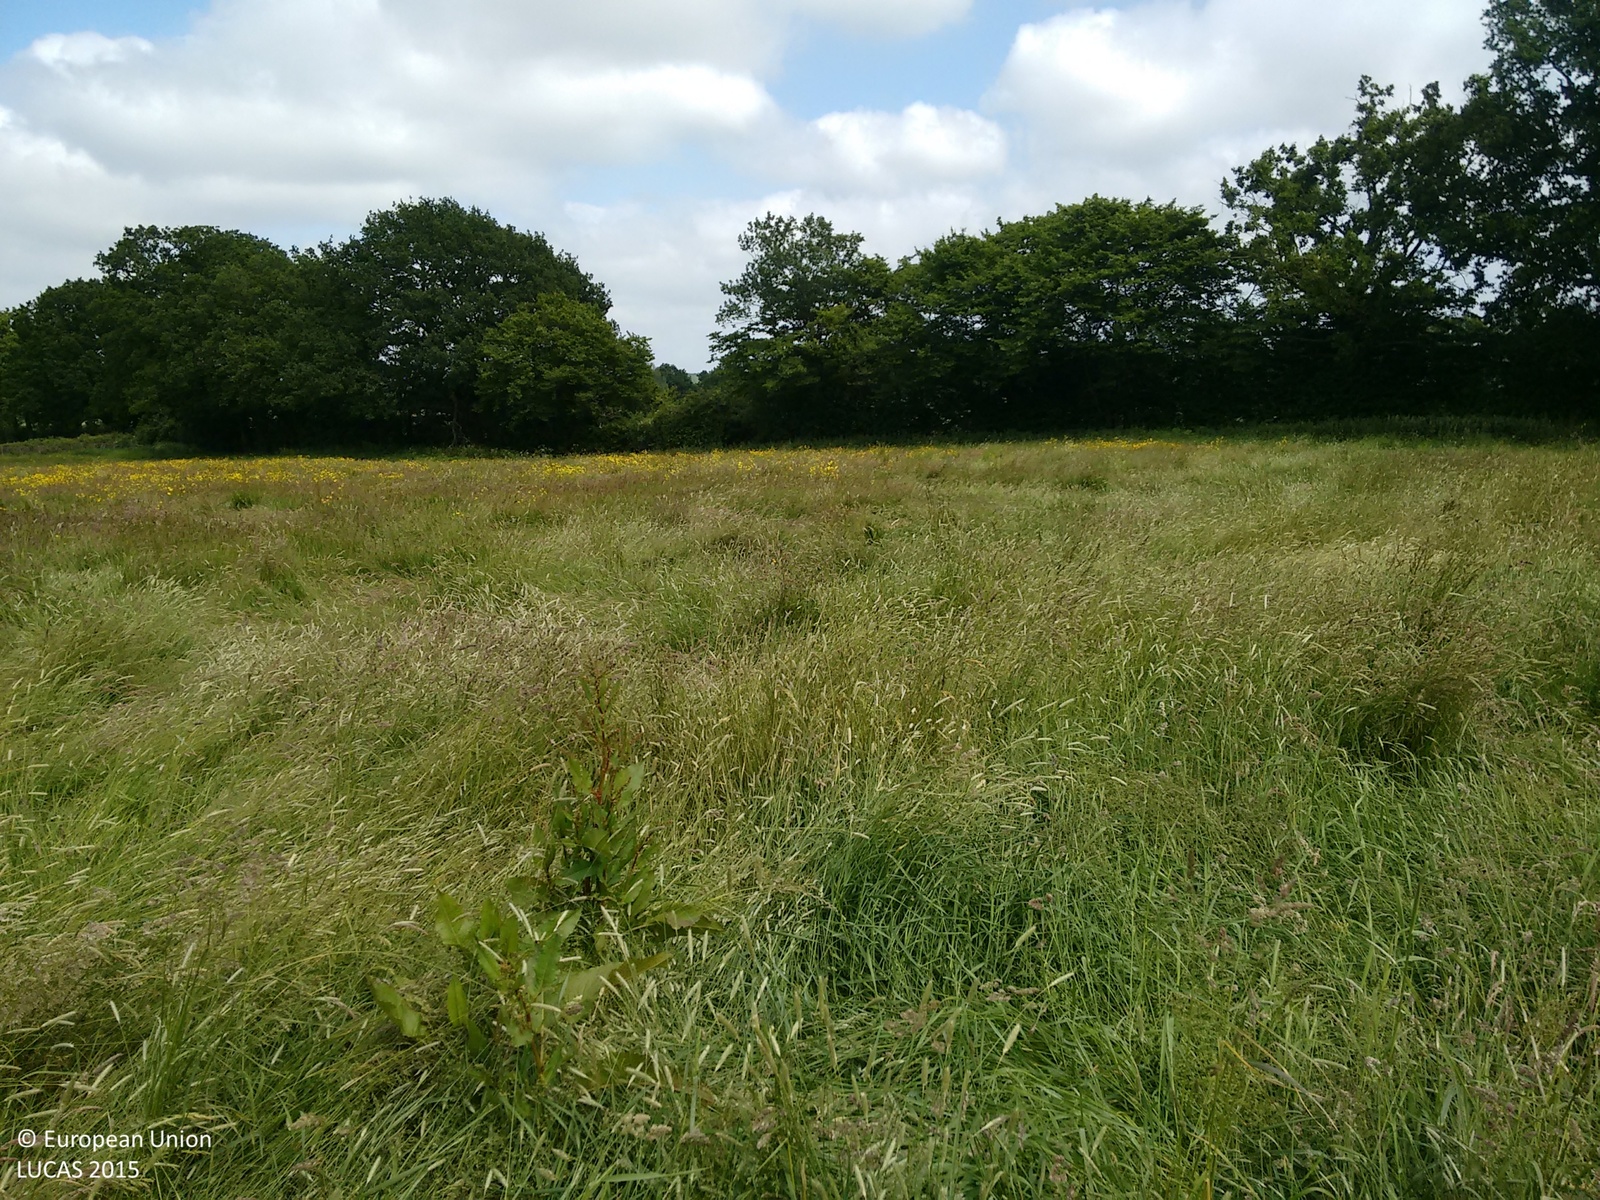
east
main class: Grassland
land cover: Grassland without tree/shrub cover
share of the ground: > 75 %
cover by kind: herbaceous plants 100 %
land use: Agriculture (excluding fallow land and kitchen gardens)
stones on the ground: < 10 %
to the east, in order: Grassland without tree/shrub cover; Fences; Managed hedges; Grassland without tree/shrub cover; Common wheat
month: June
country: GB
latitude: 51.1335
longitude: 0.5838
